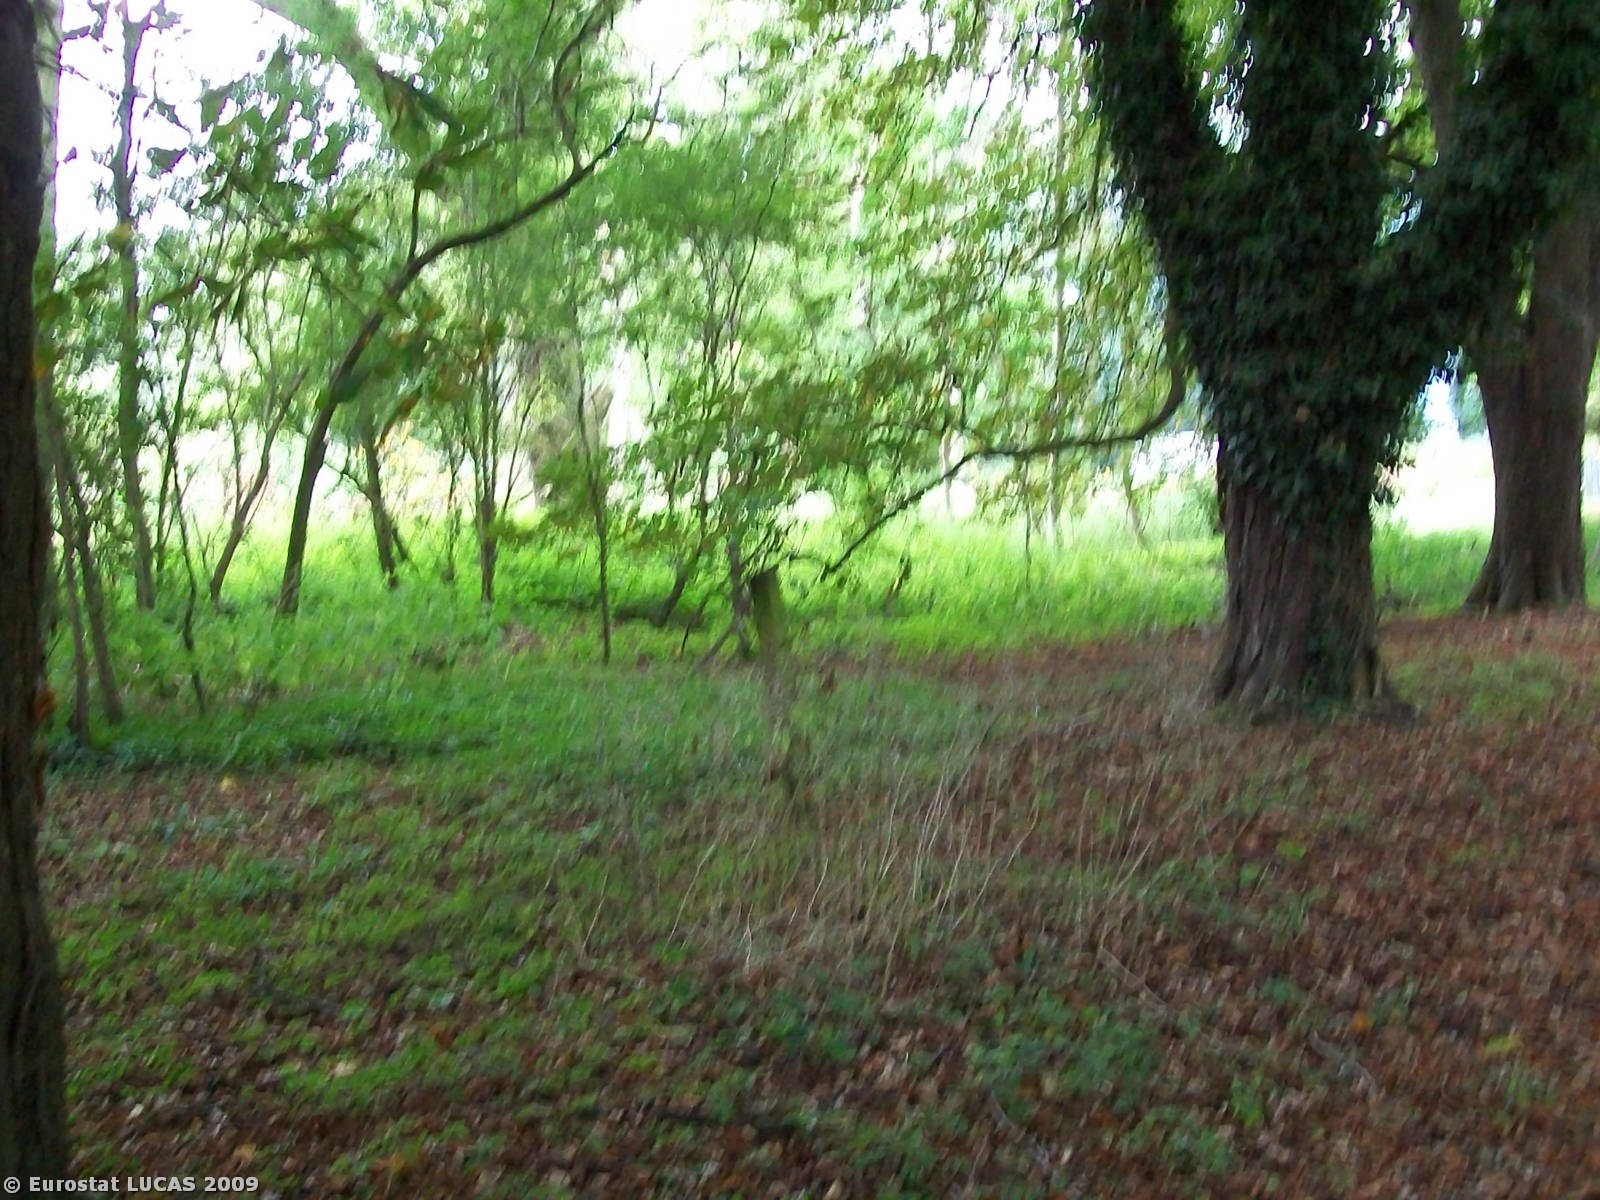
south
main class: Woodland
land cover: Broadleaved woodland
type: mesophytic deciduous forest
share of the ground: > 75 %
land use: Unused
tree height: > 5 m
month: August
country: GB
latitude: 51.3890
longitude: -1.0384
